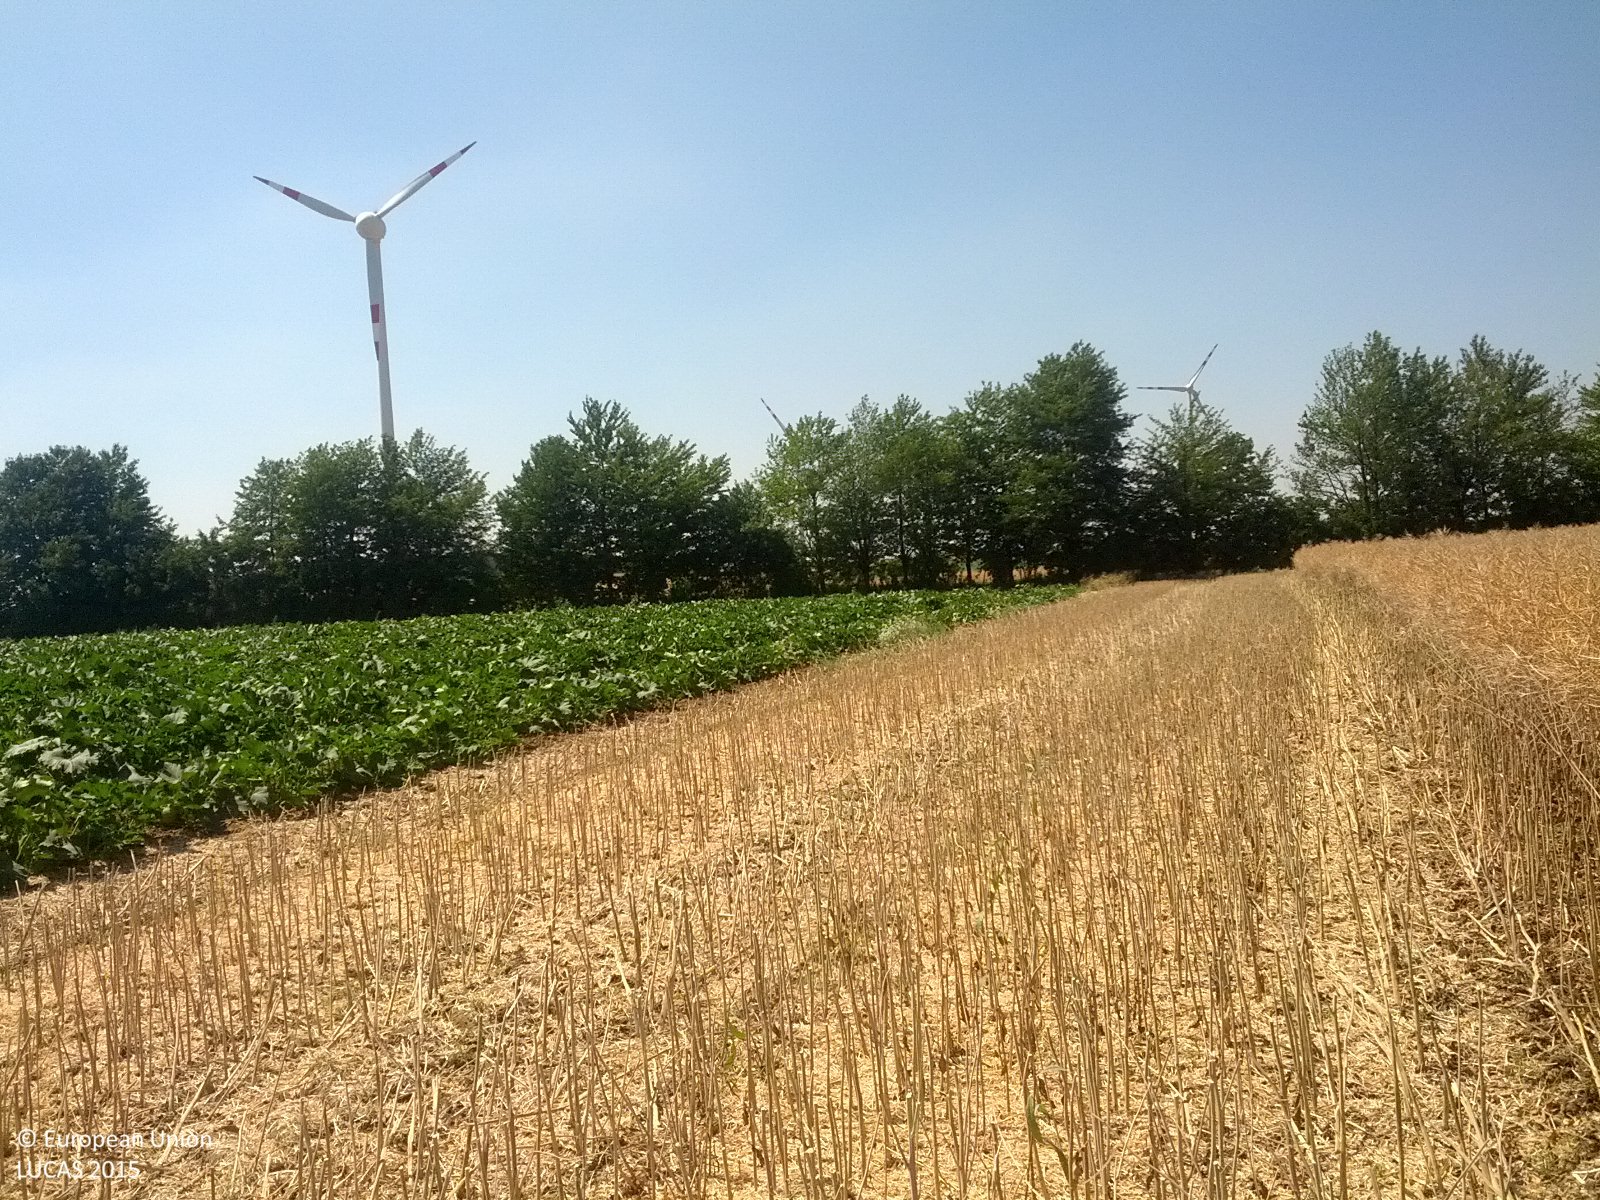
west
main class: Cropland
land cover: Rape and turnip rape
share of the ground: > 75 %
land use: Agriculture (excluding fallow land and kitchen gardens)
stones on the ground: < 10 %
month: July
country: AT
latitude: 48.5132
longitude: 16.5991
